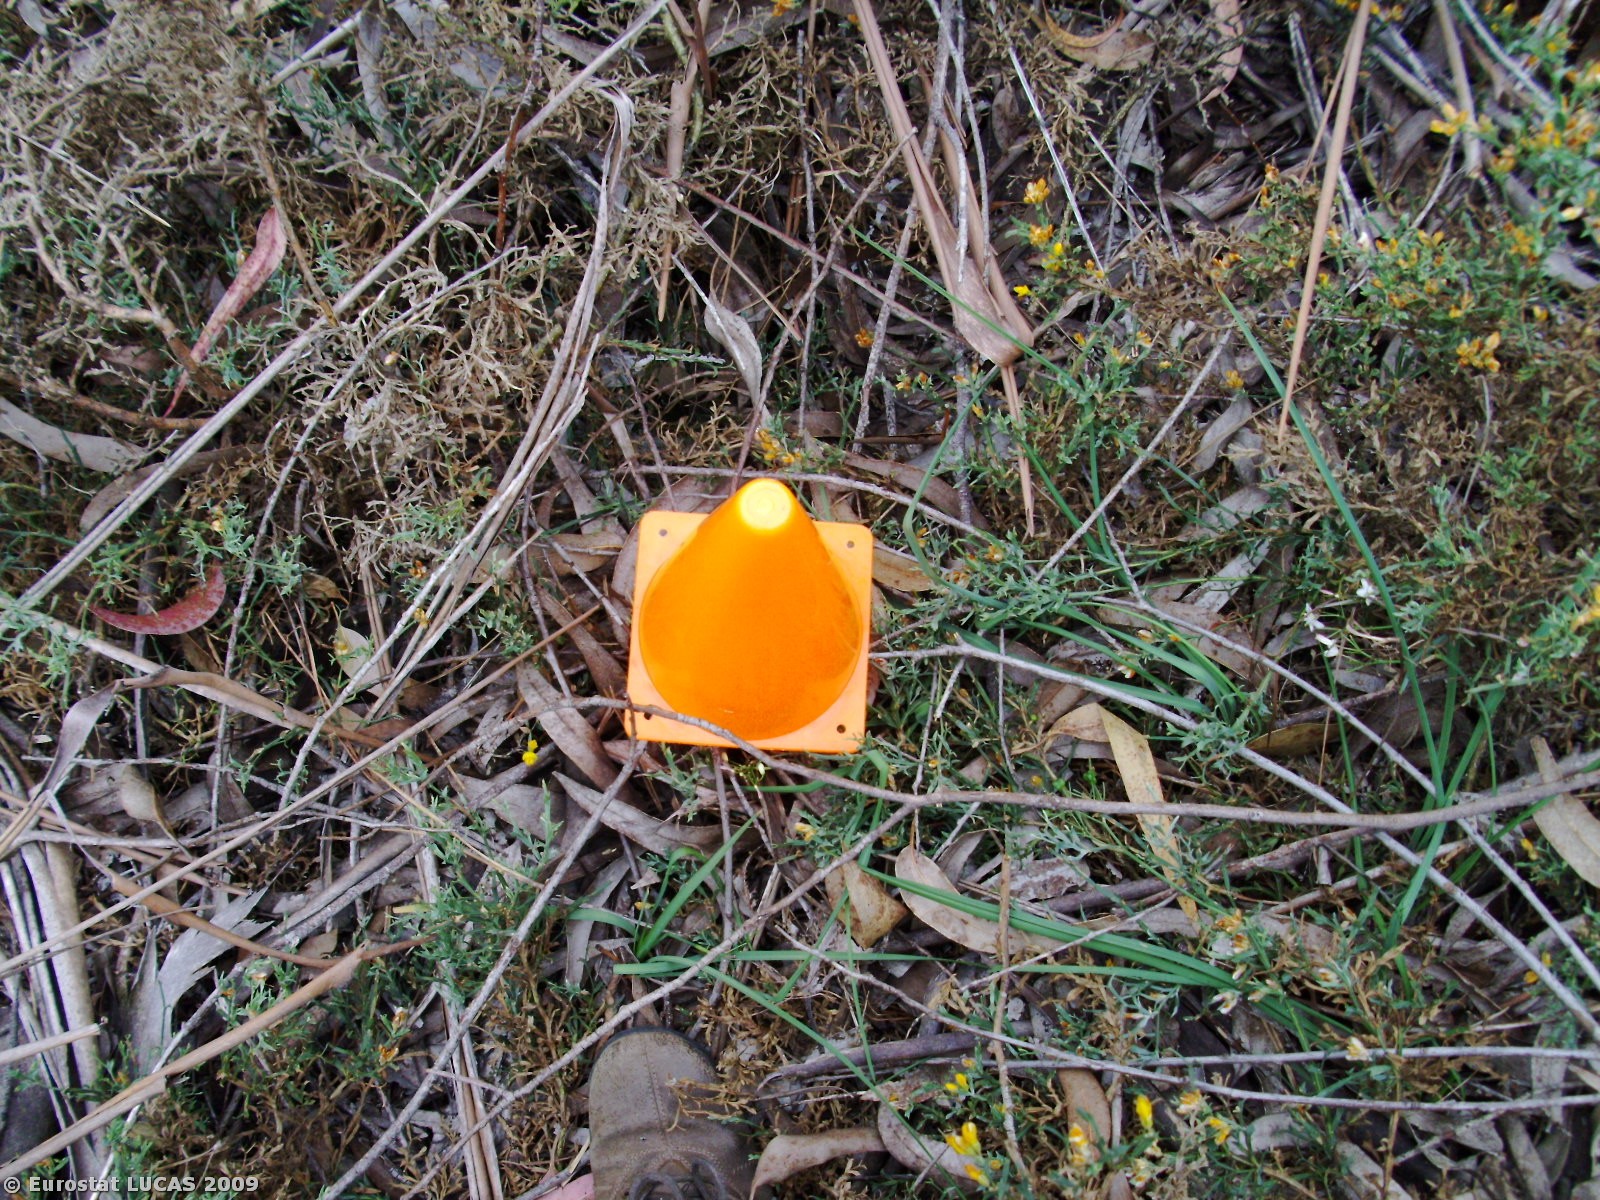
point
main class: Woodland
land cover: Broadleaved woodland
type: plantations and self-sown exotic forest
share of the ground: > 75 %
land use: Forestry
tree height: > 5 m
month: May
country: PT
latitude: 40.3558
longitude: -8.3220
